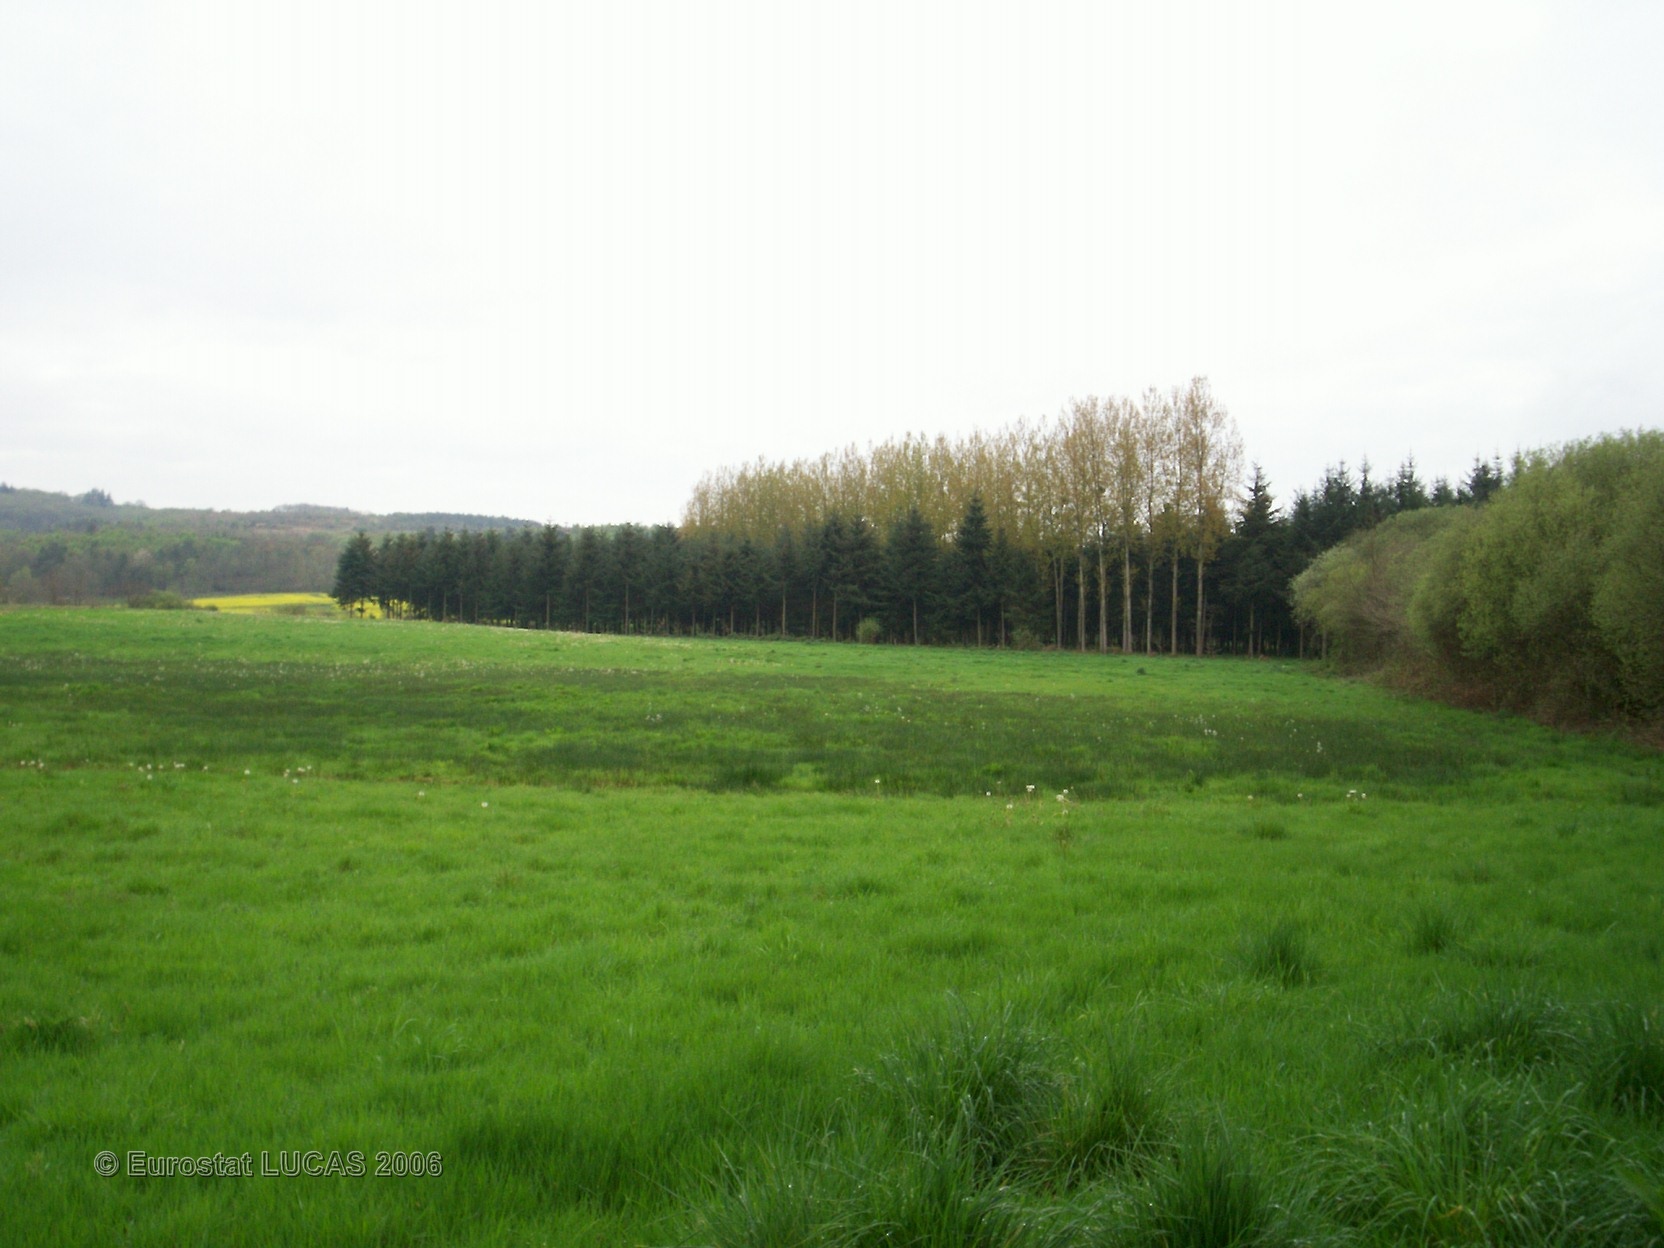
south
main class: Grassland
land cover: Grassland without tree/shrub cover
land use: Agriculture (excluding fallow land and kitchen gardens)
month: April
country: FR
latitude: 48.0055
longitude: -2.2943
